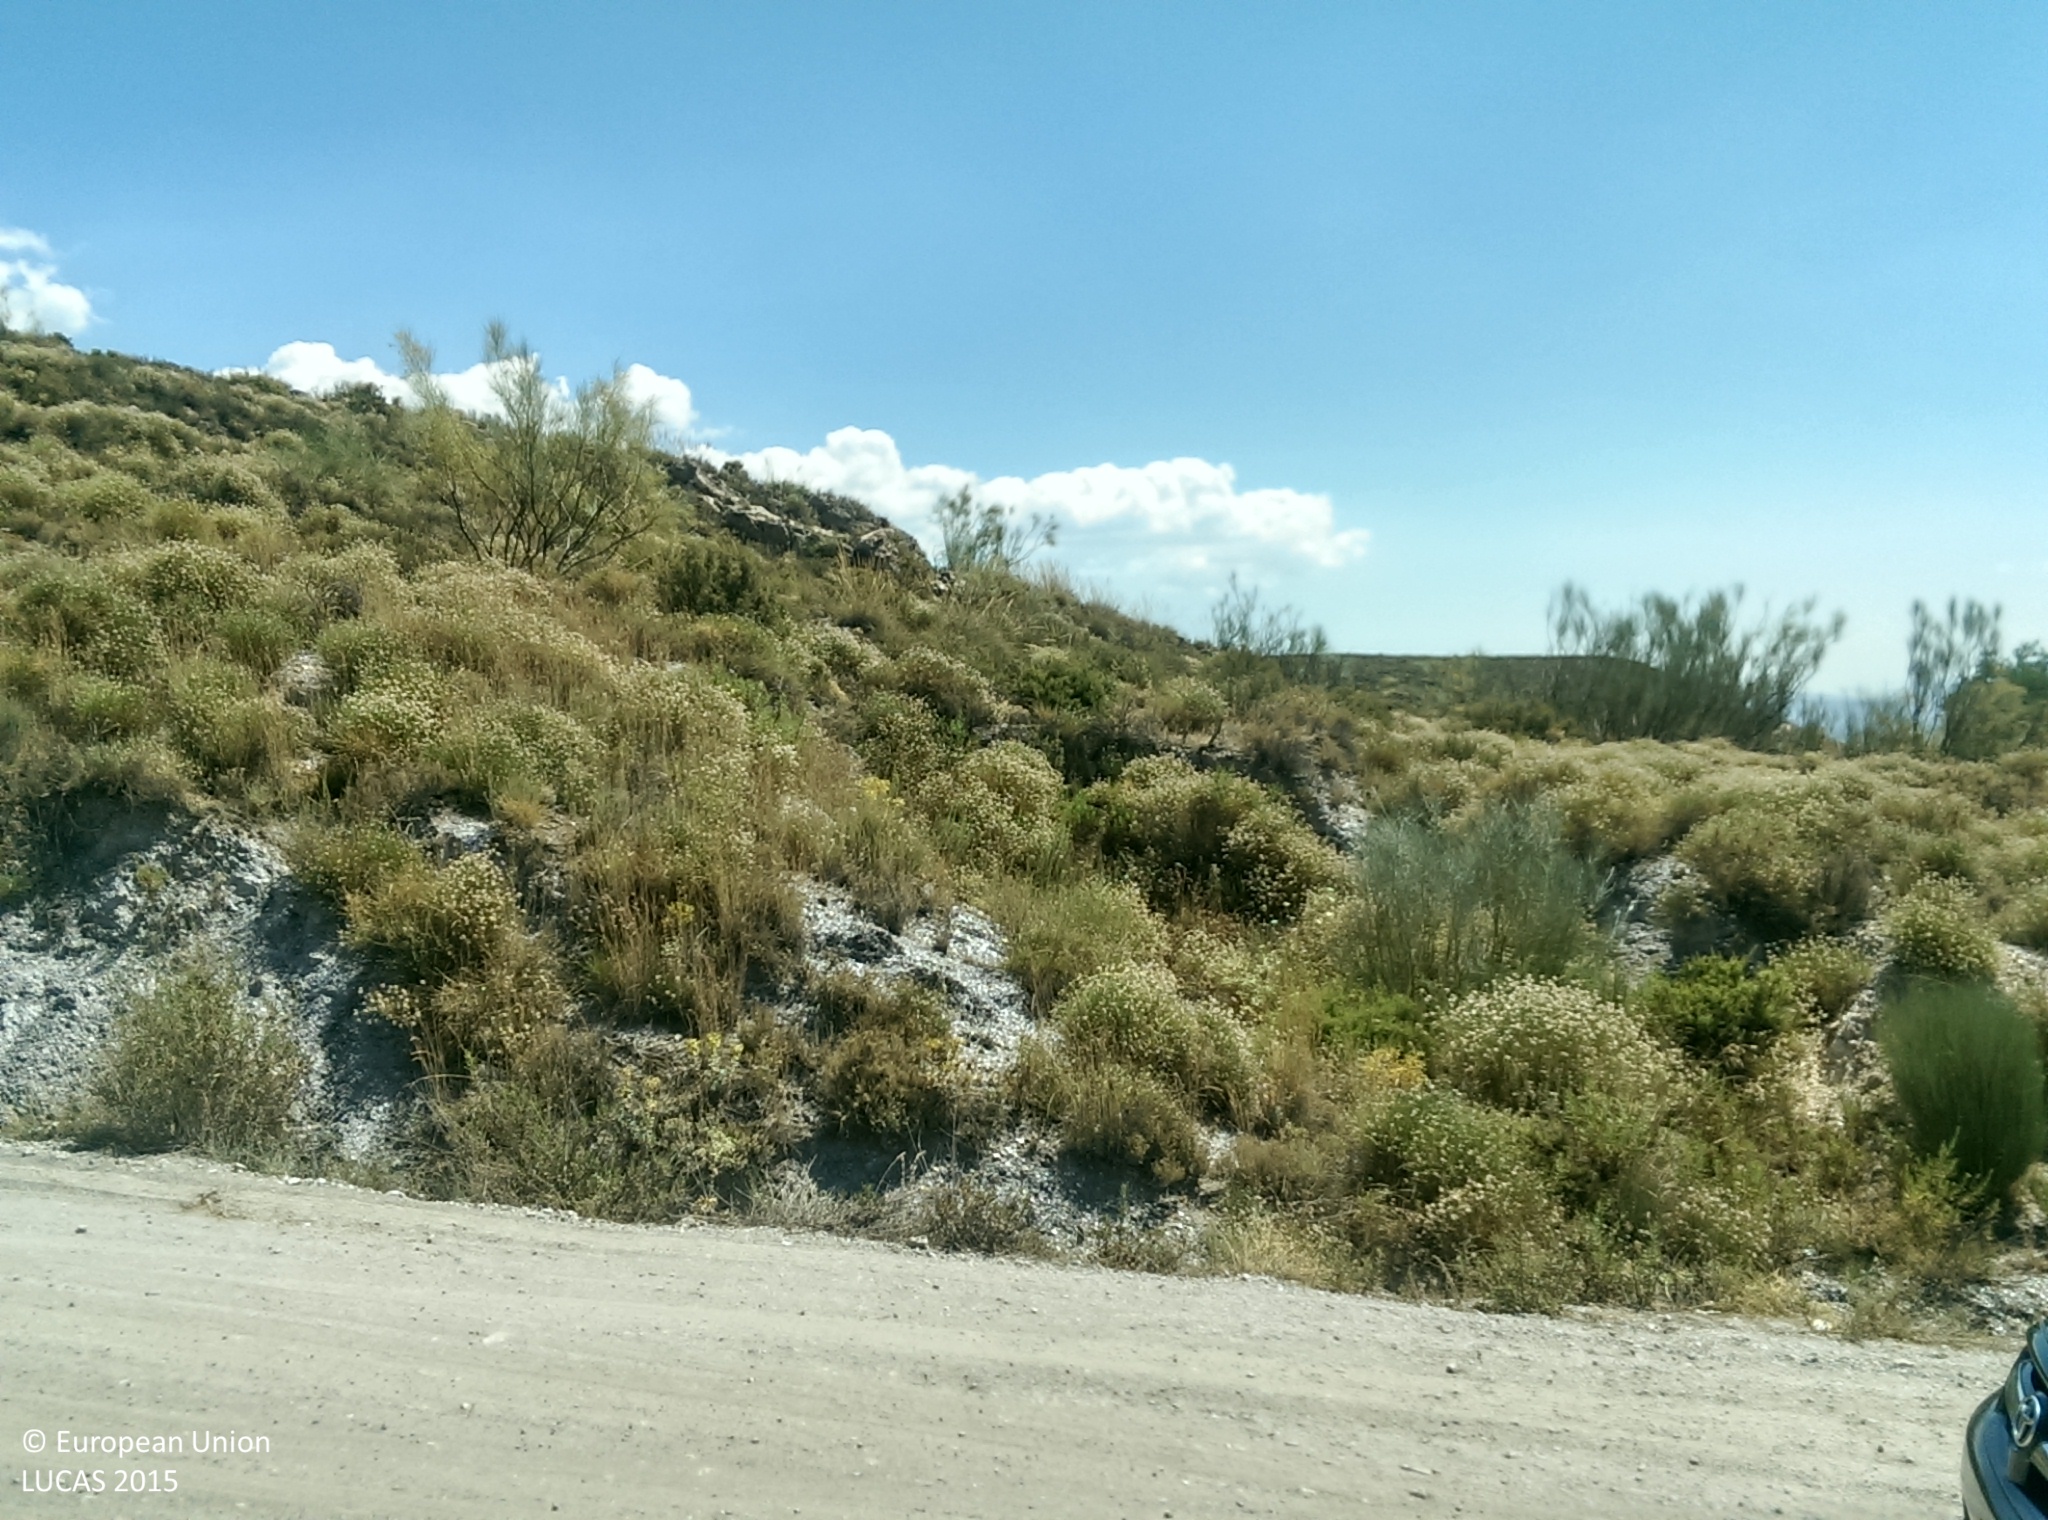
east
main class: Shrubland
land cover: Shrubland without tree cover
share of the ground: > 75 %
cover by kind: shrubs 75 %, herbaceous plants 20 %, unconsolidated bare surface 5 %
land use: Semi-natural and natural areas not in use
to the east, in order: Shrubland without tree cover
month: July
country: ES
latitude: 36.9787
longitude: -3.1369
